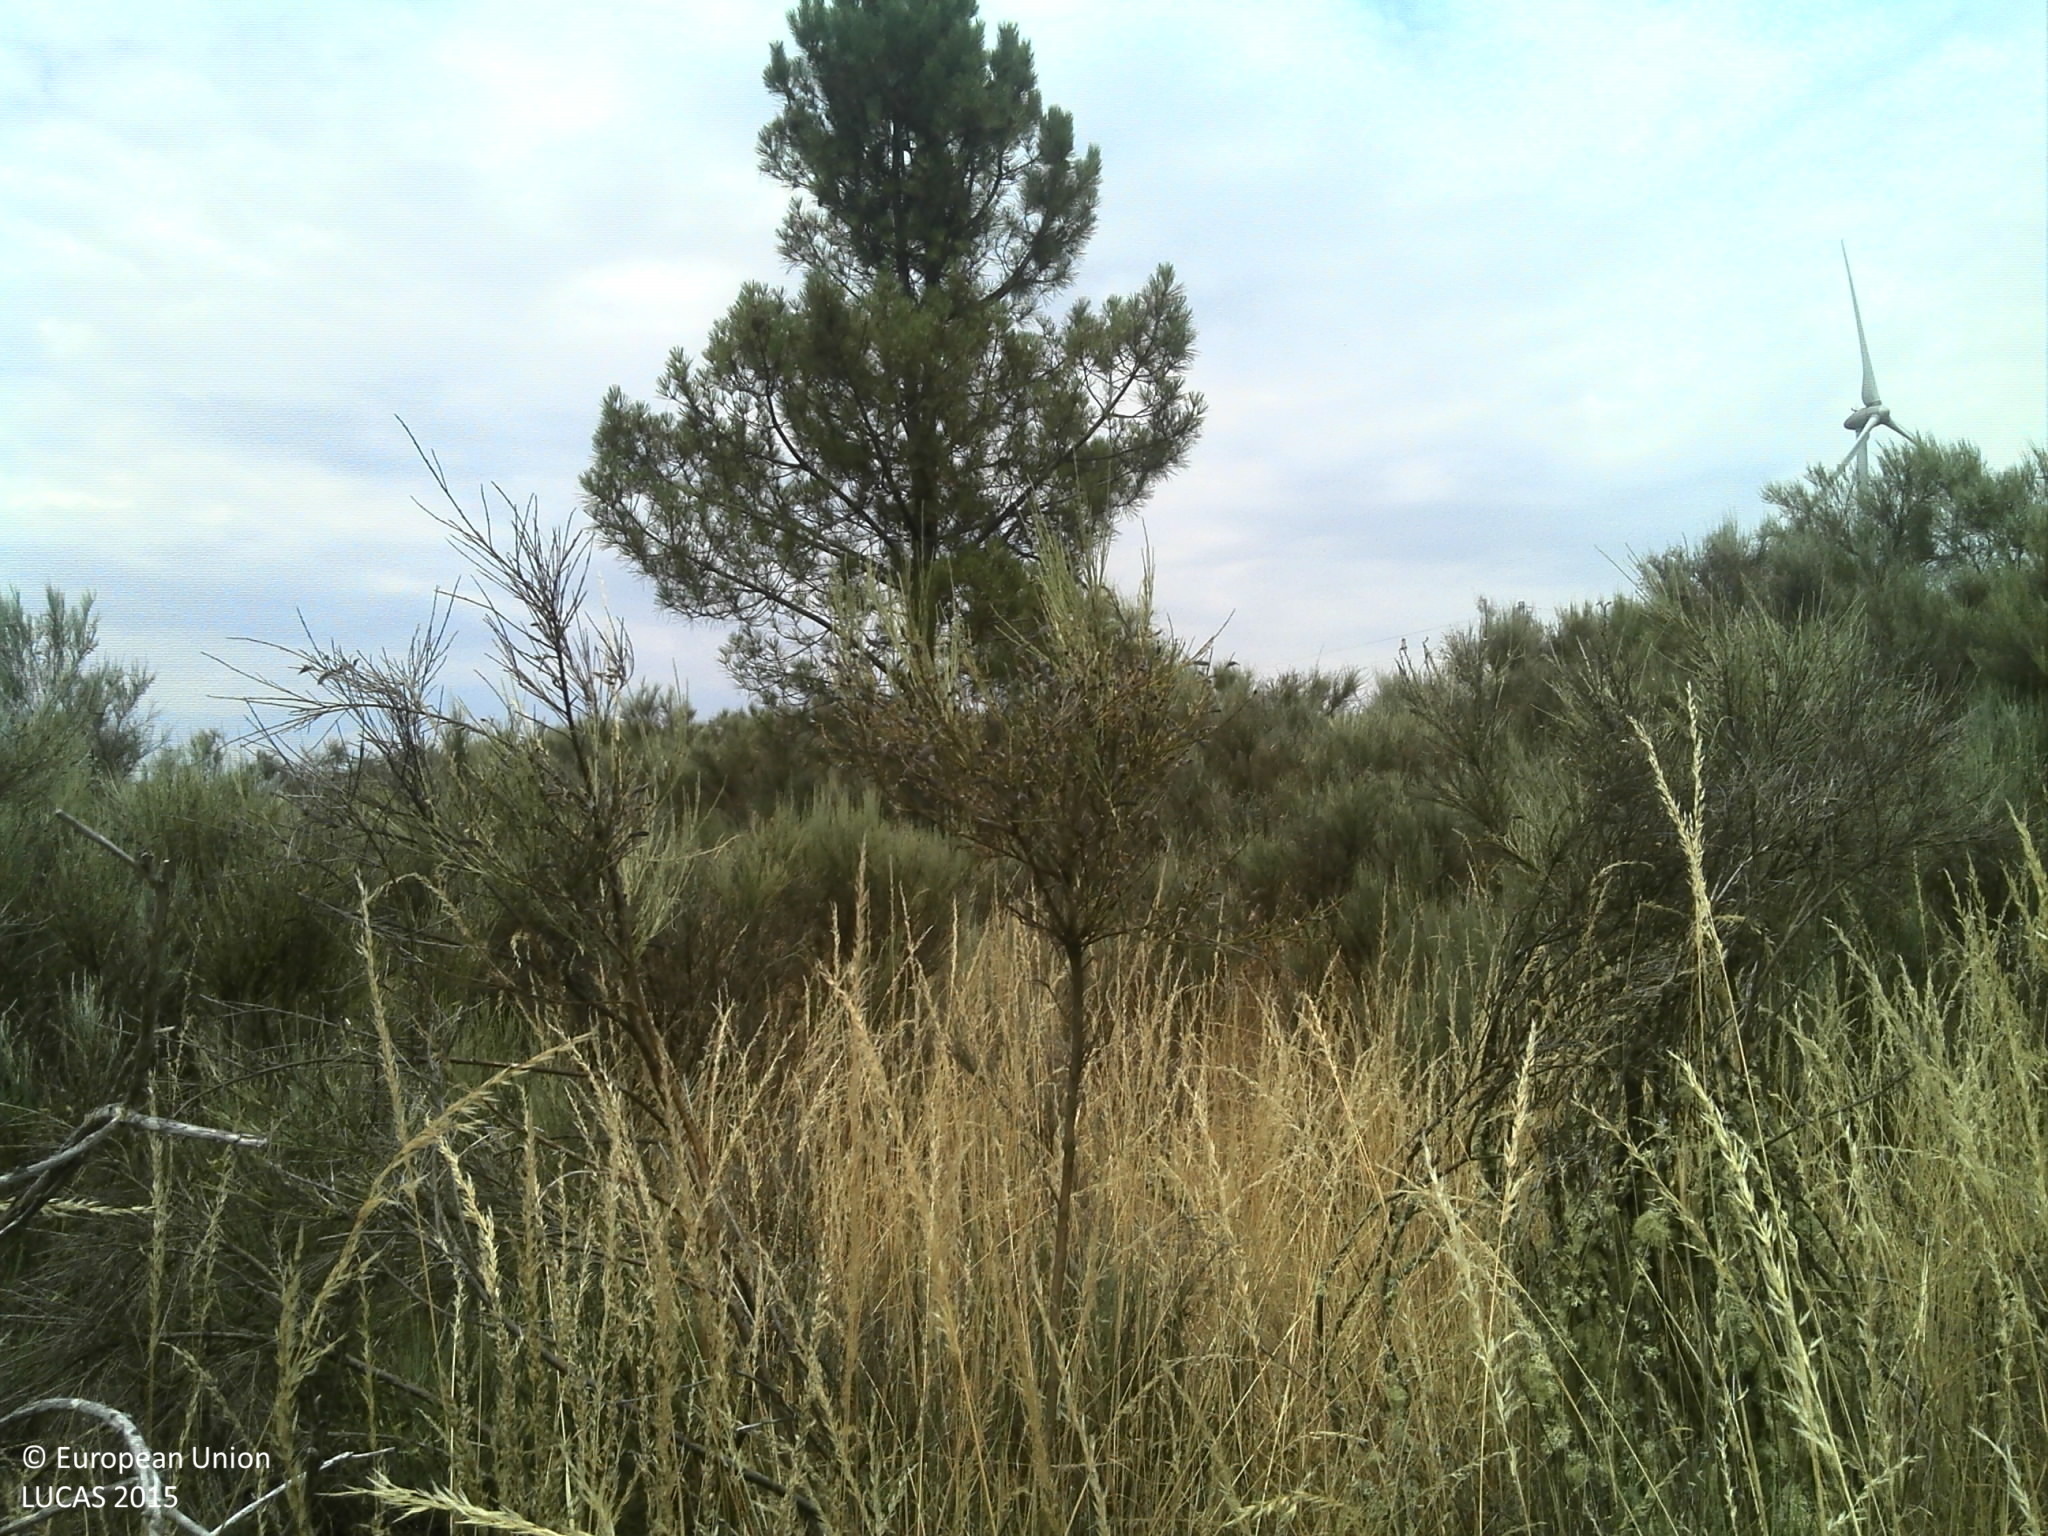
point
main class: Shrubland
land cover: Shrubland with sparse tree cover
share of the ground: 50 - 75 %
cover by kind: shrubs 65 %, herbaceous plants 15 %, unconsolidated bare surface 10 %, coniferous forest trees 5 %, consolidated bare surface 5 %
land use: Semi-natural and natural areas not in use
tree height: > 5 m
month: July
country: PT
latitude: 41.0107
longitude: -7.3691
